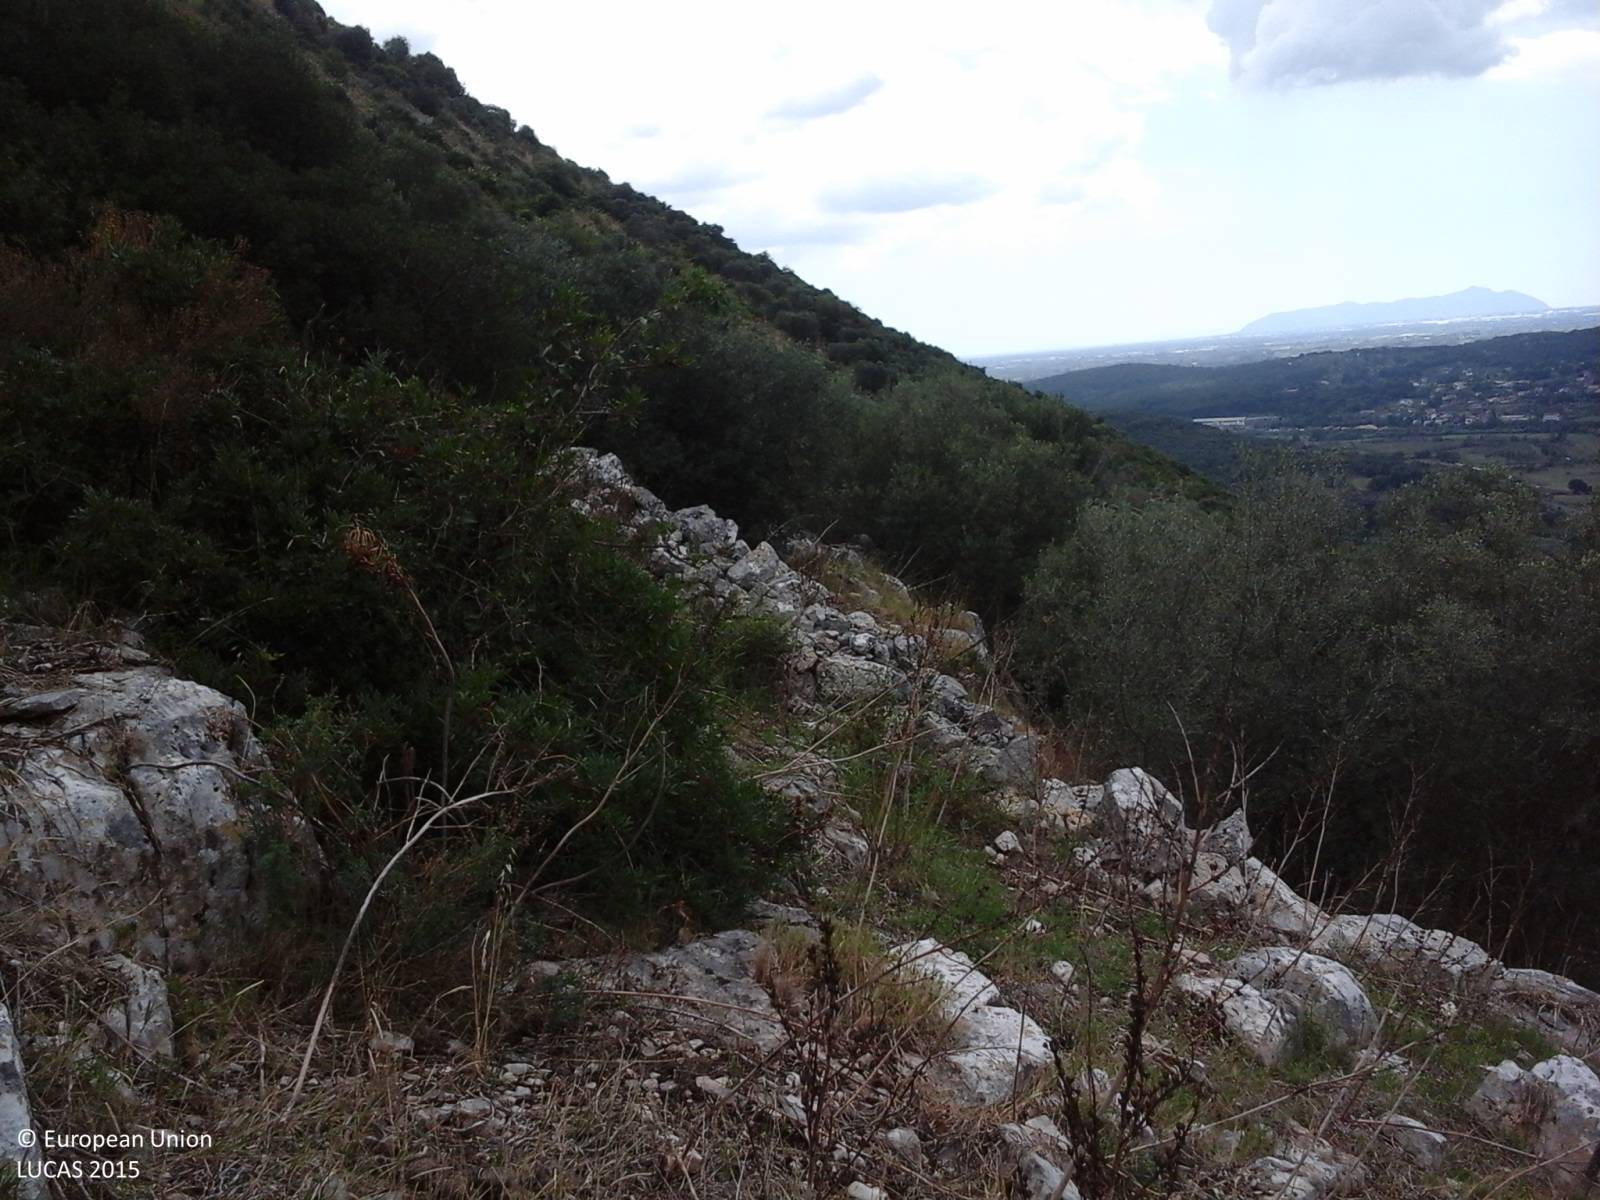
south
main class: Cropland
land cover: Olive groves
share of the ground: 25 - 50 %
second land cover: Grassland without tree/shrub cover
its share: 25 - 50 %
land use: Abandoned areas
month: August
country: IT
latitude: 41.4821
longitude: 13.2090
